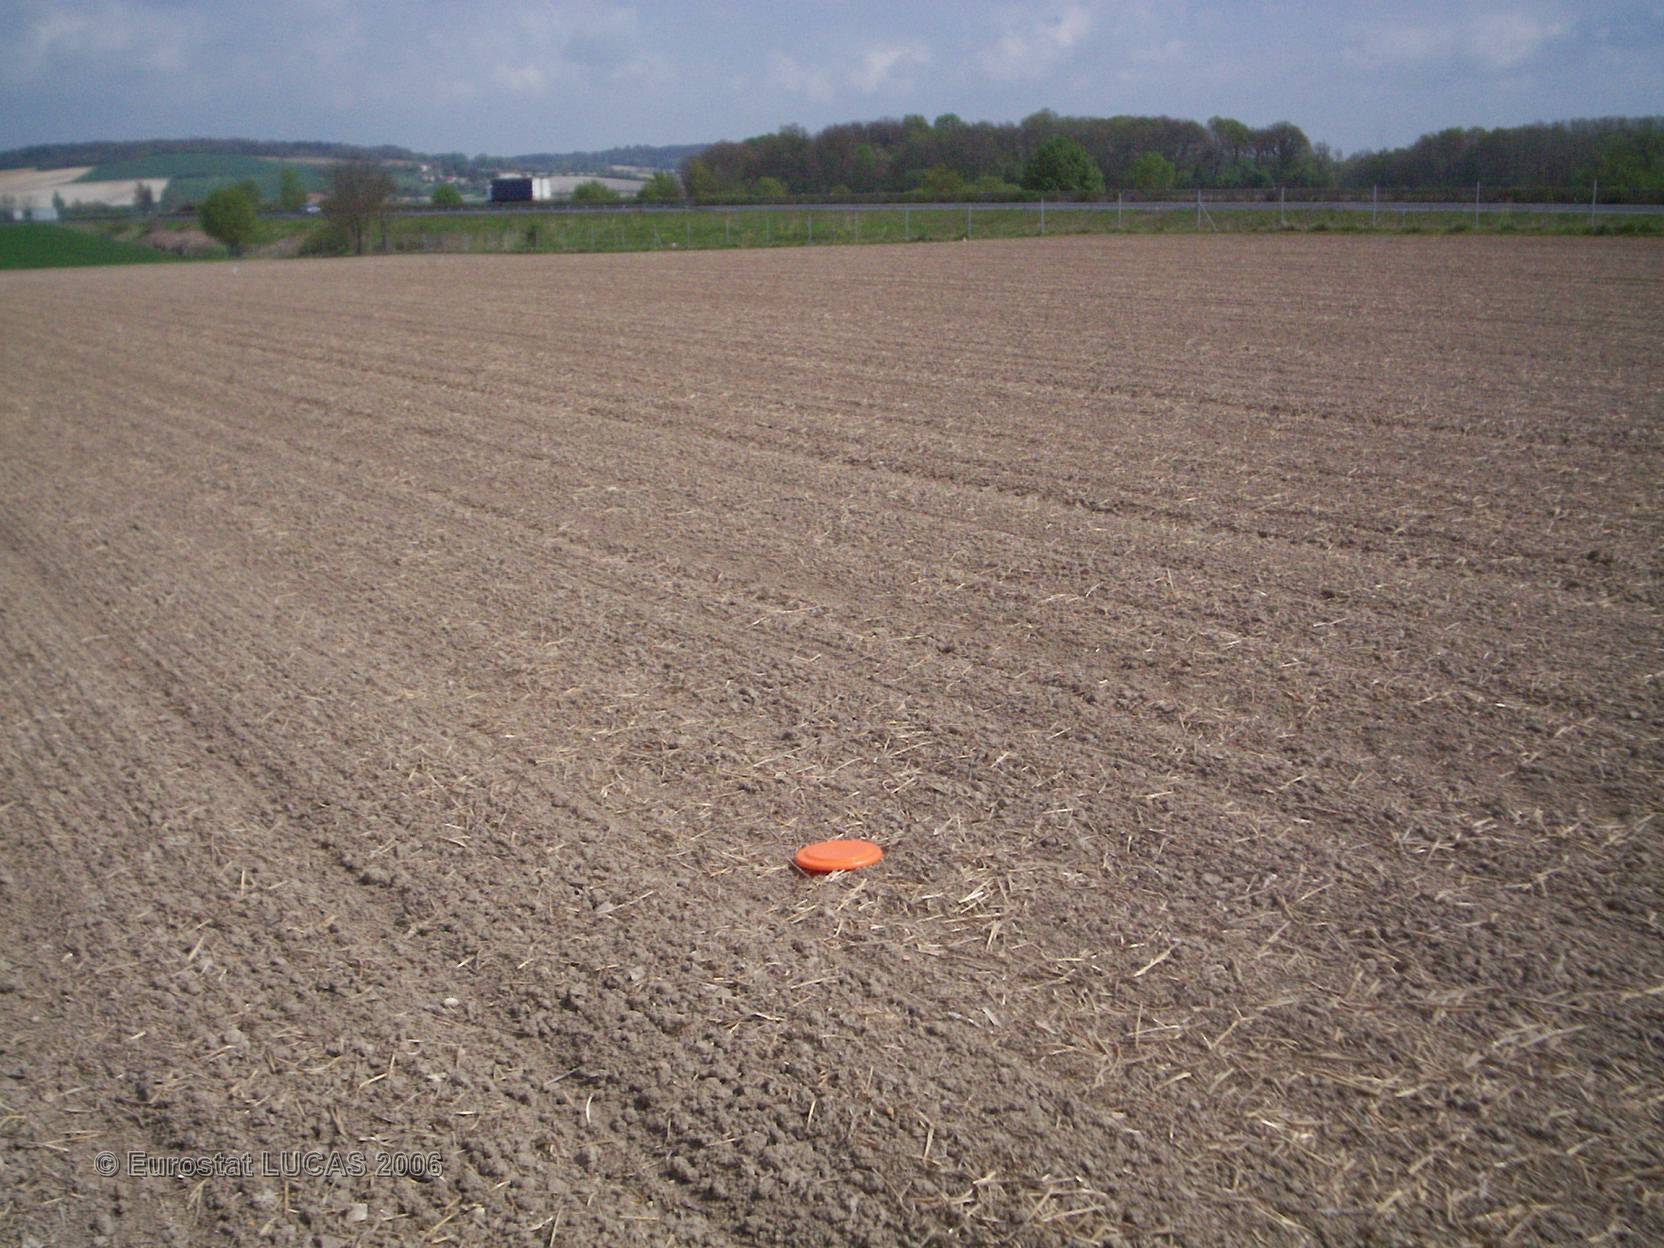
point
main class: Cropland
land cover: Maize
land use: Agriculture (excluding fallow land and kitchen gardens)
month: June
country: FR
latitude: 46.8542
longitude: 0.5250
